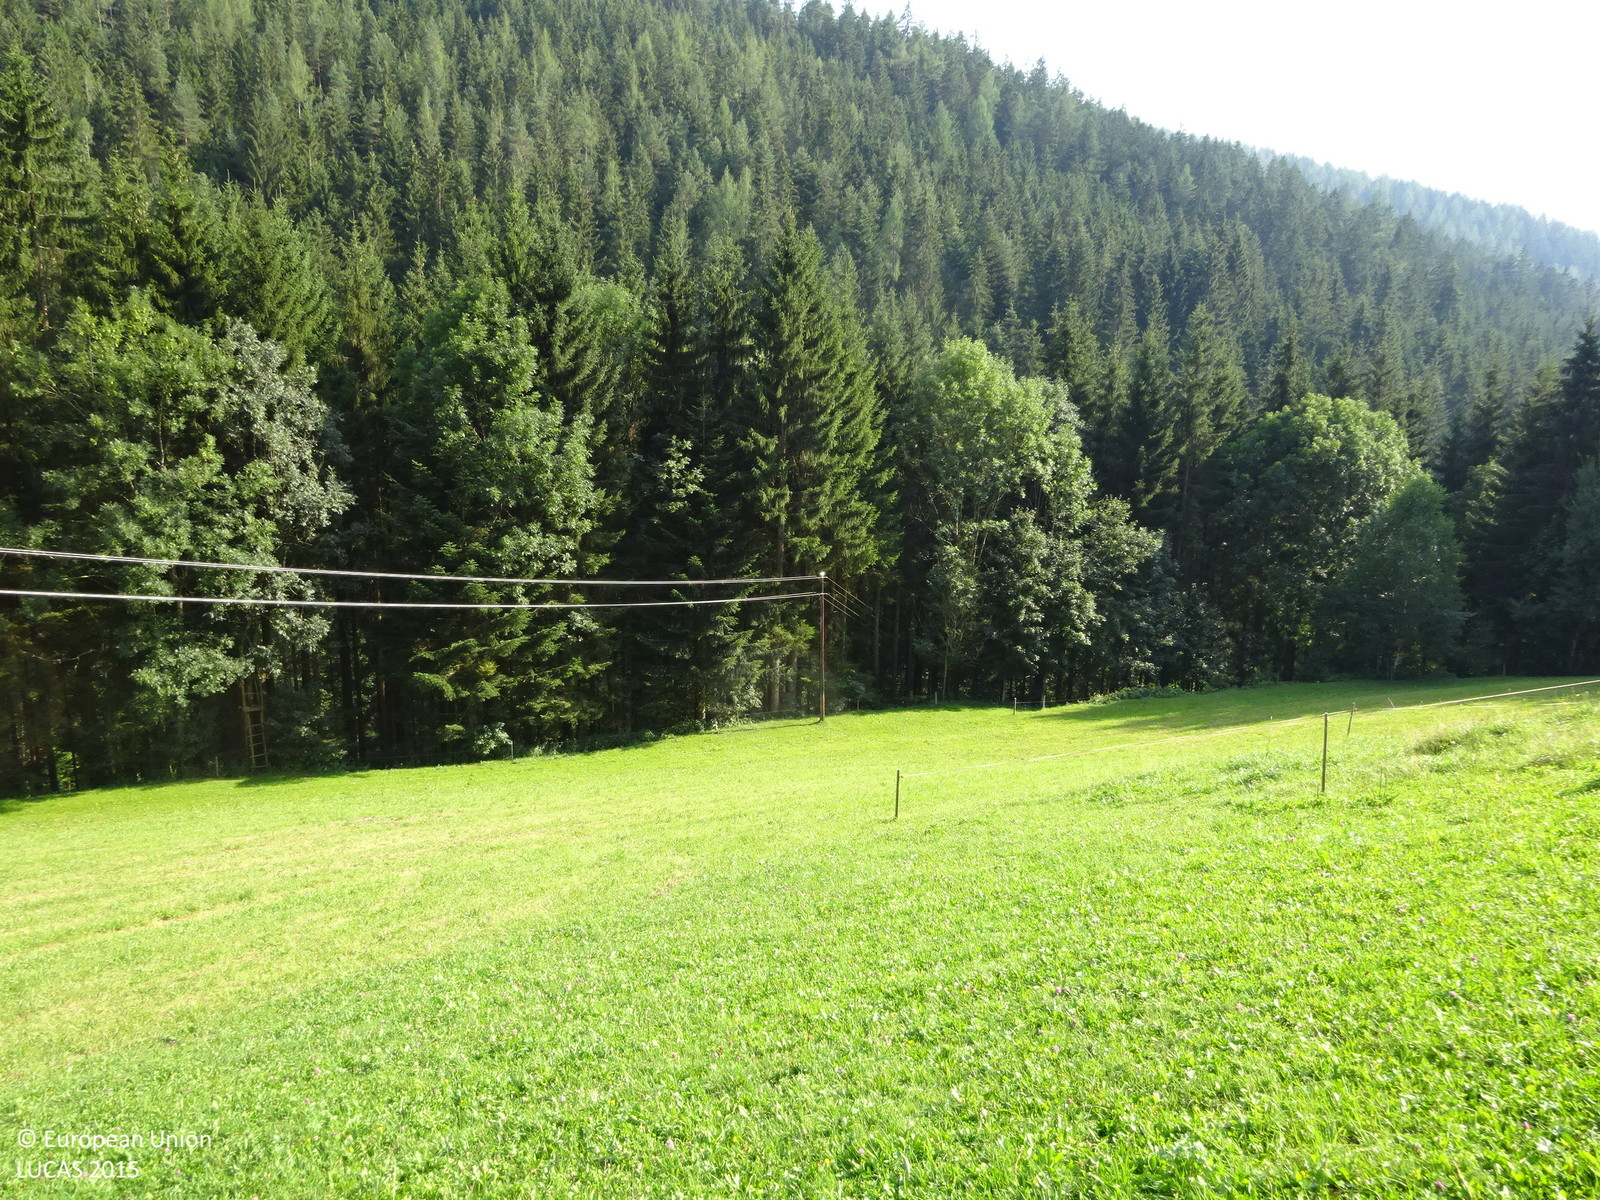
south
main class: Grassland
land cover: Grassland without tree/shrub cover
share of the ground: > 75 %
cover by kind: herbaceous plants 100 %
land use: Agriculture (excluding fallow land and kitchen gardens)
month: August
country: AT
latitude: 47.4962
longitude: 15.7493
